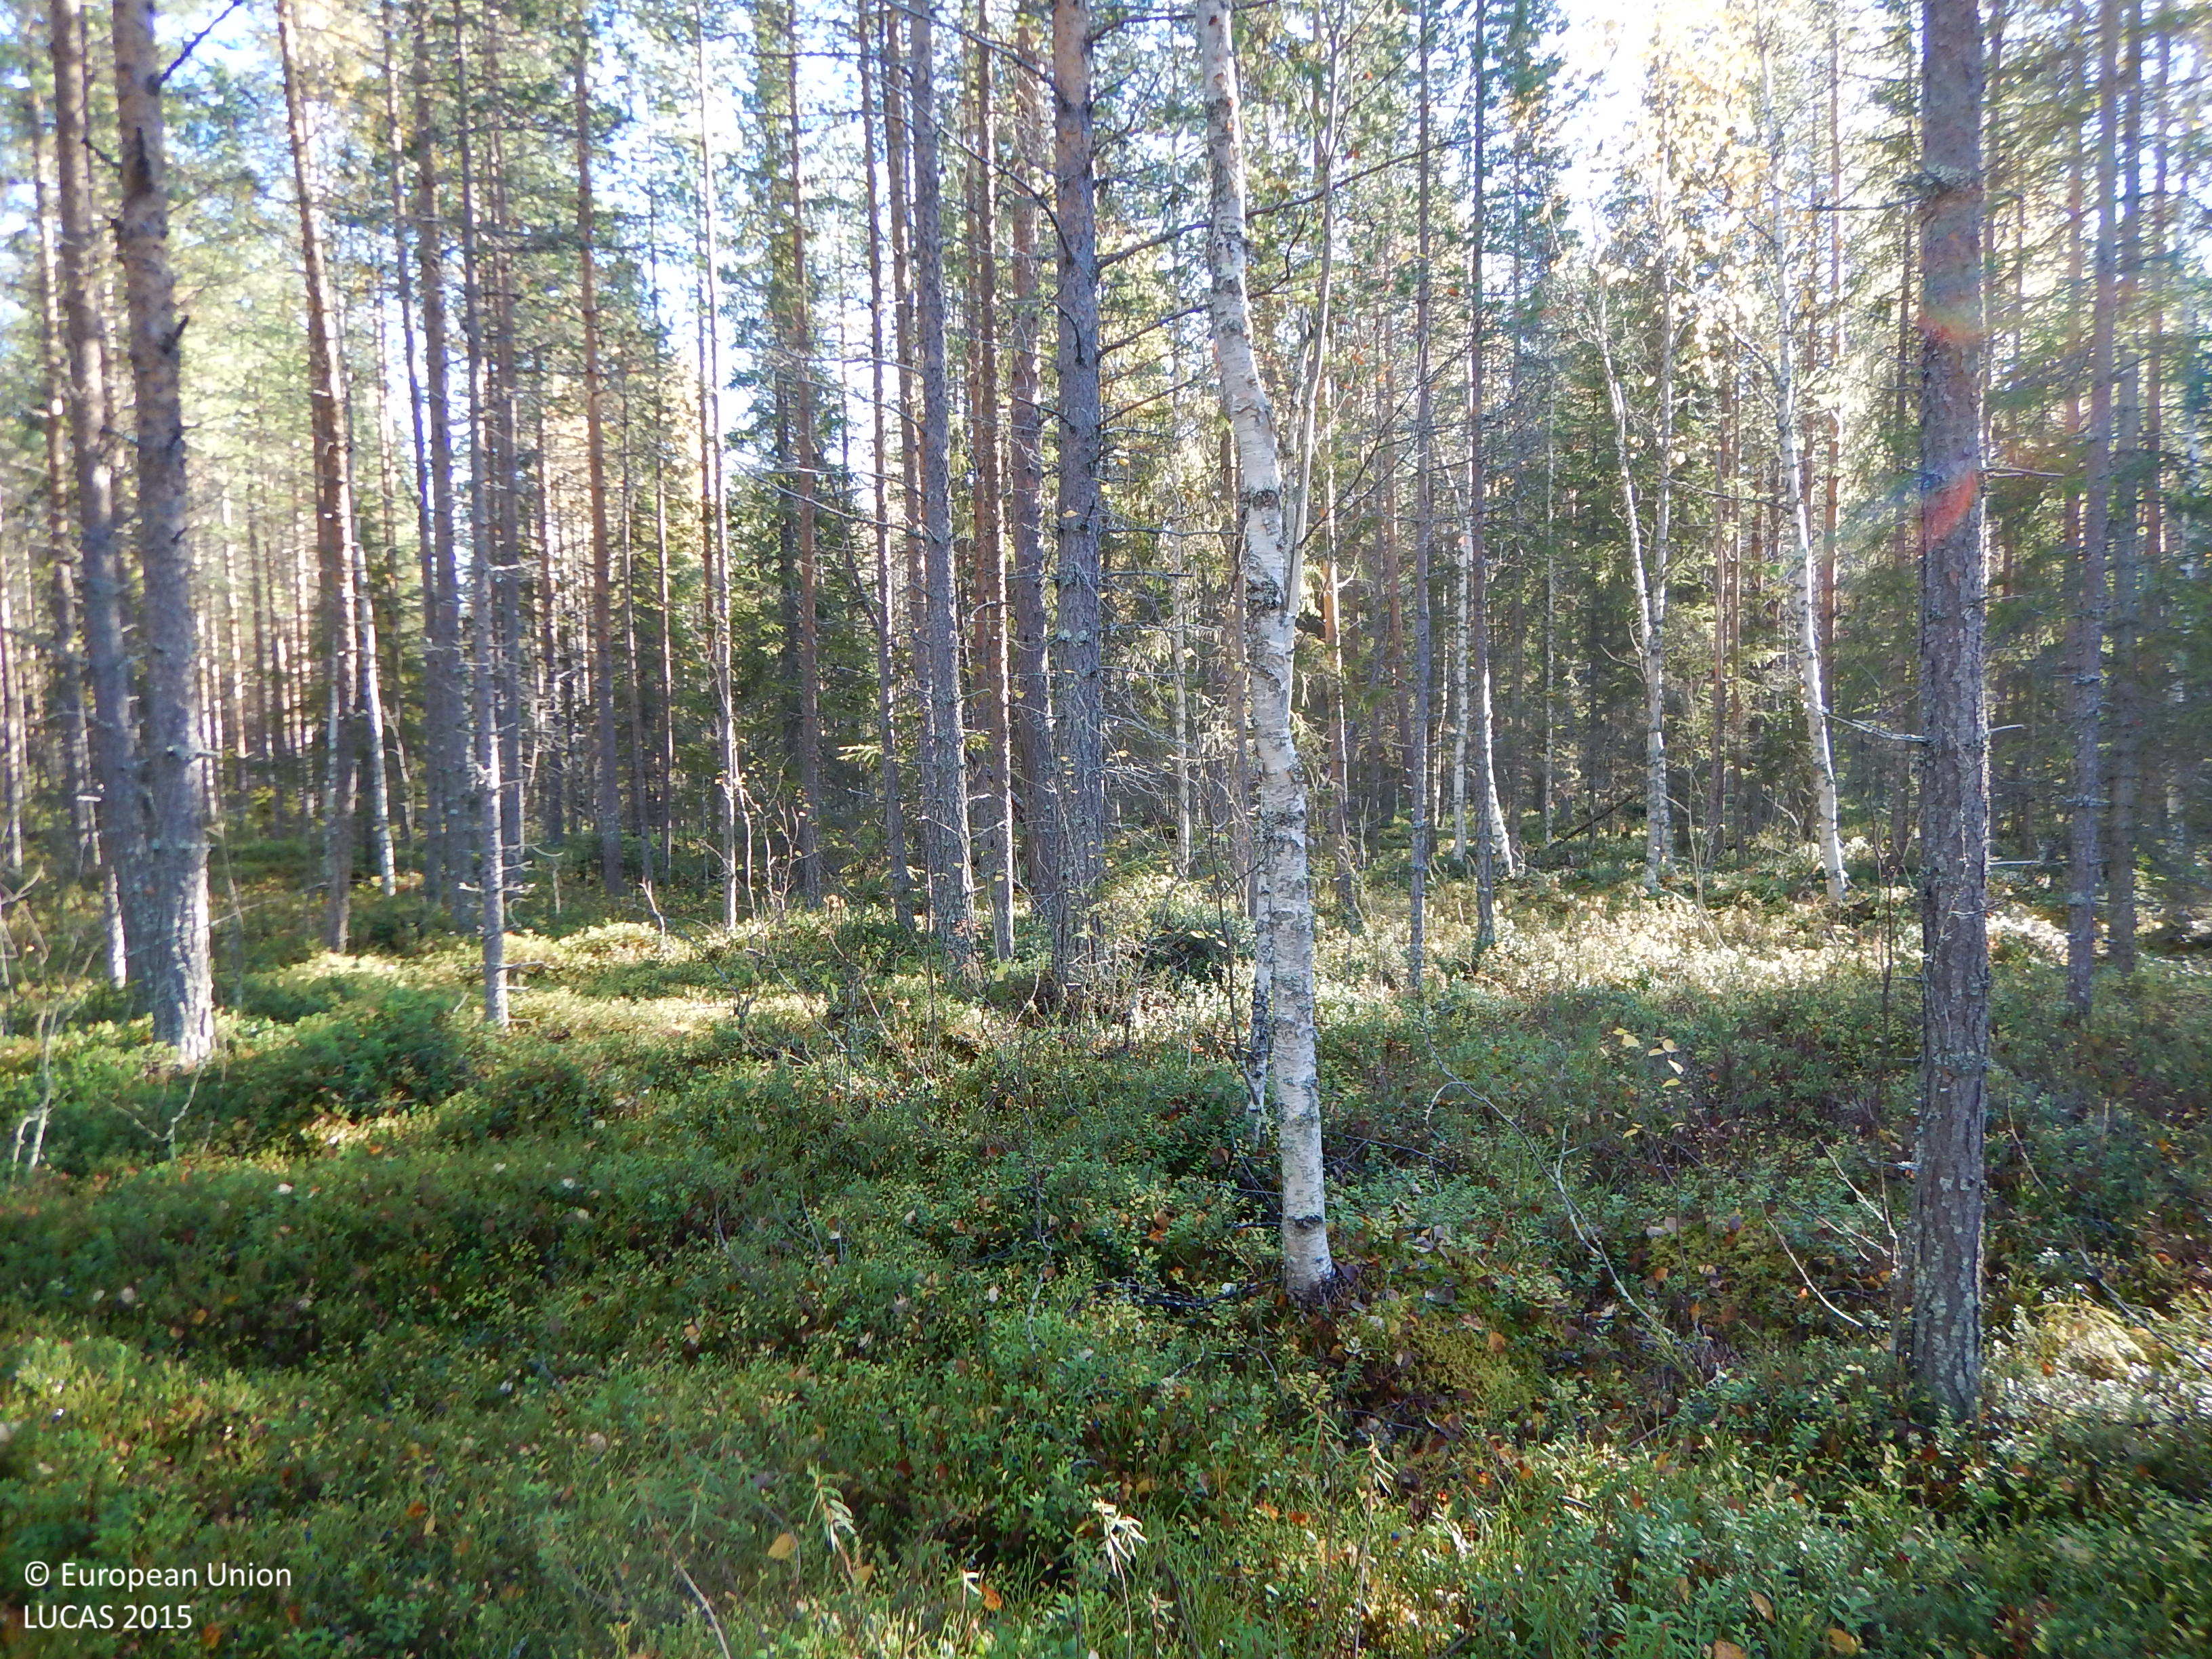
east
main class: Woodland
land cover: Pine dominated mixed woodland
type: boreal forest
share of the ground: 50 - 75 %
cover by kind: coniferous forest trees 40 %, lichens and mosses 20 %, broadleaved forest trees 15 %, shrubs 15 %, herbaceous plants 10 %
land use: Forestry
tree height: > 5 m
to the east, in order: Pine dominated mixed woodland; Other mixed woodland; Ditches and canals; Other mixed woodland; Ditches and canals; Pine dominated mixed woodland; Grass margins; Electric lines; Pine dominated mixed woodland; Ditches and canals; Grass margins; Paved roads, cycling and walking lanes
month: September
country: SE
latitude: 64.8893
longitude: 19.9172
